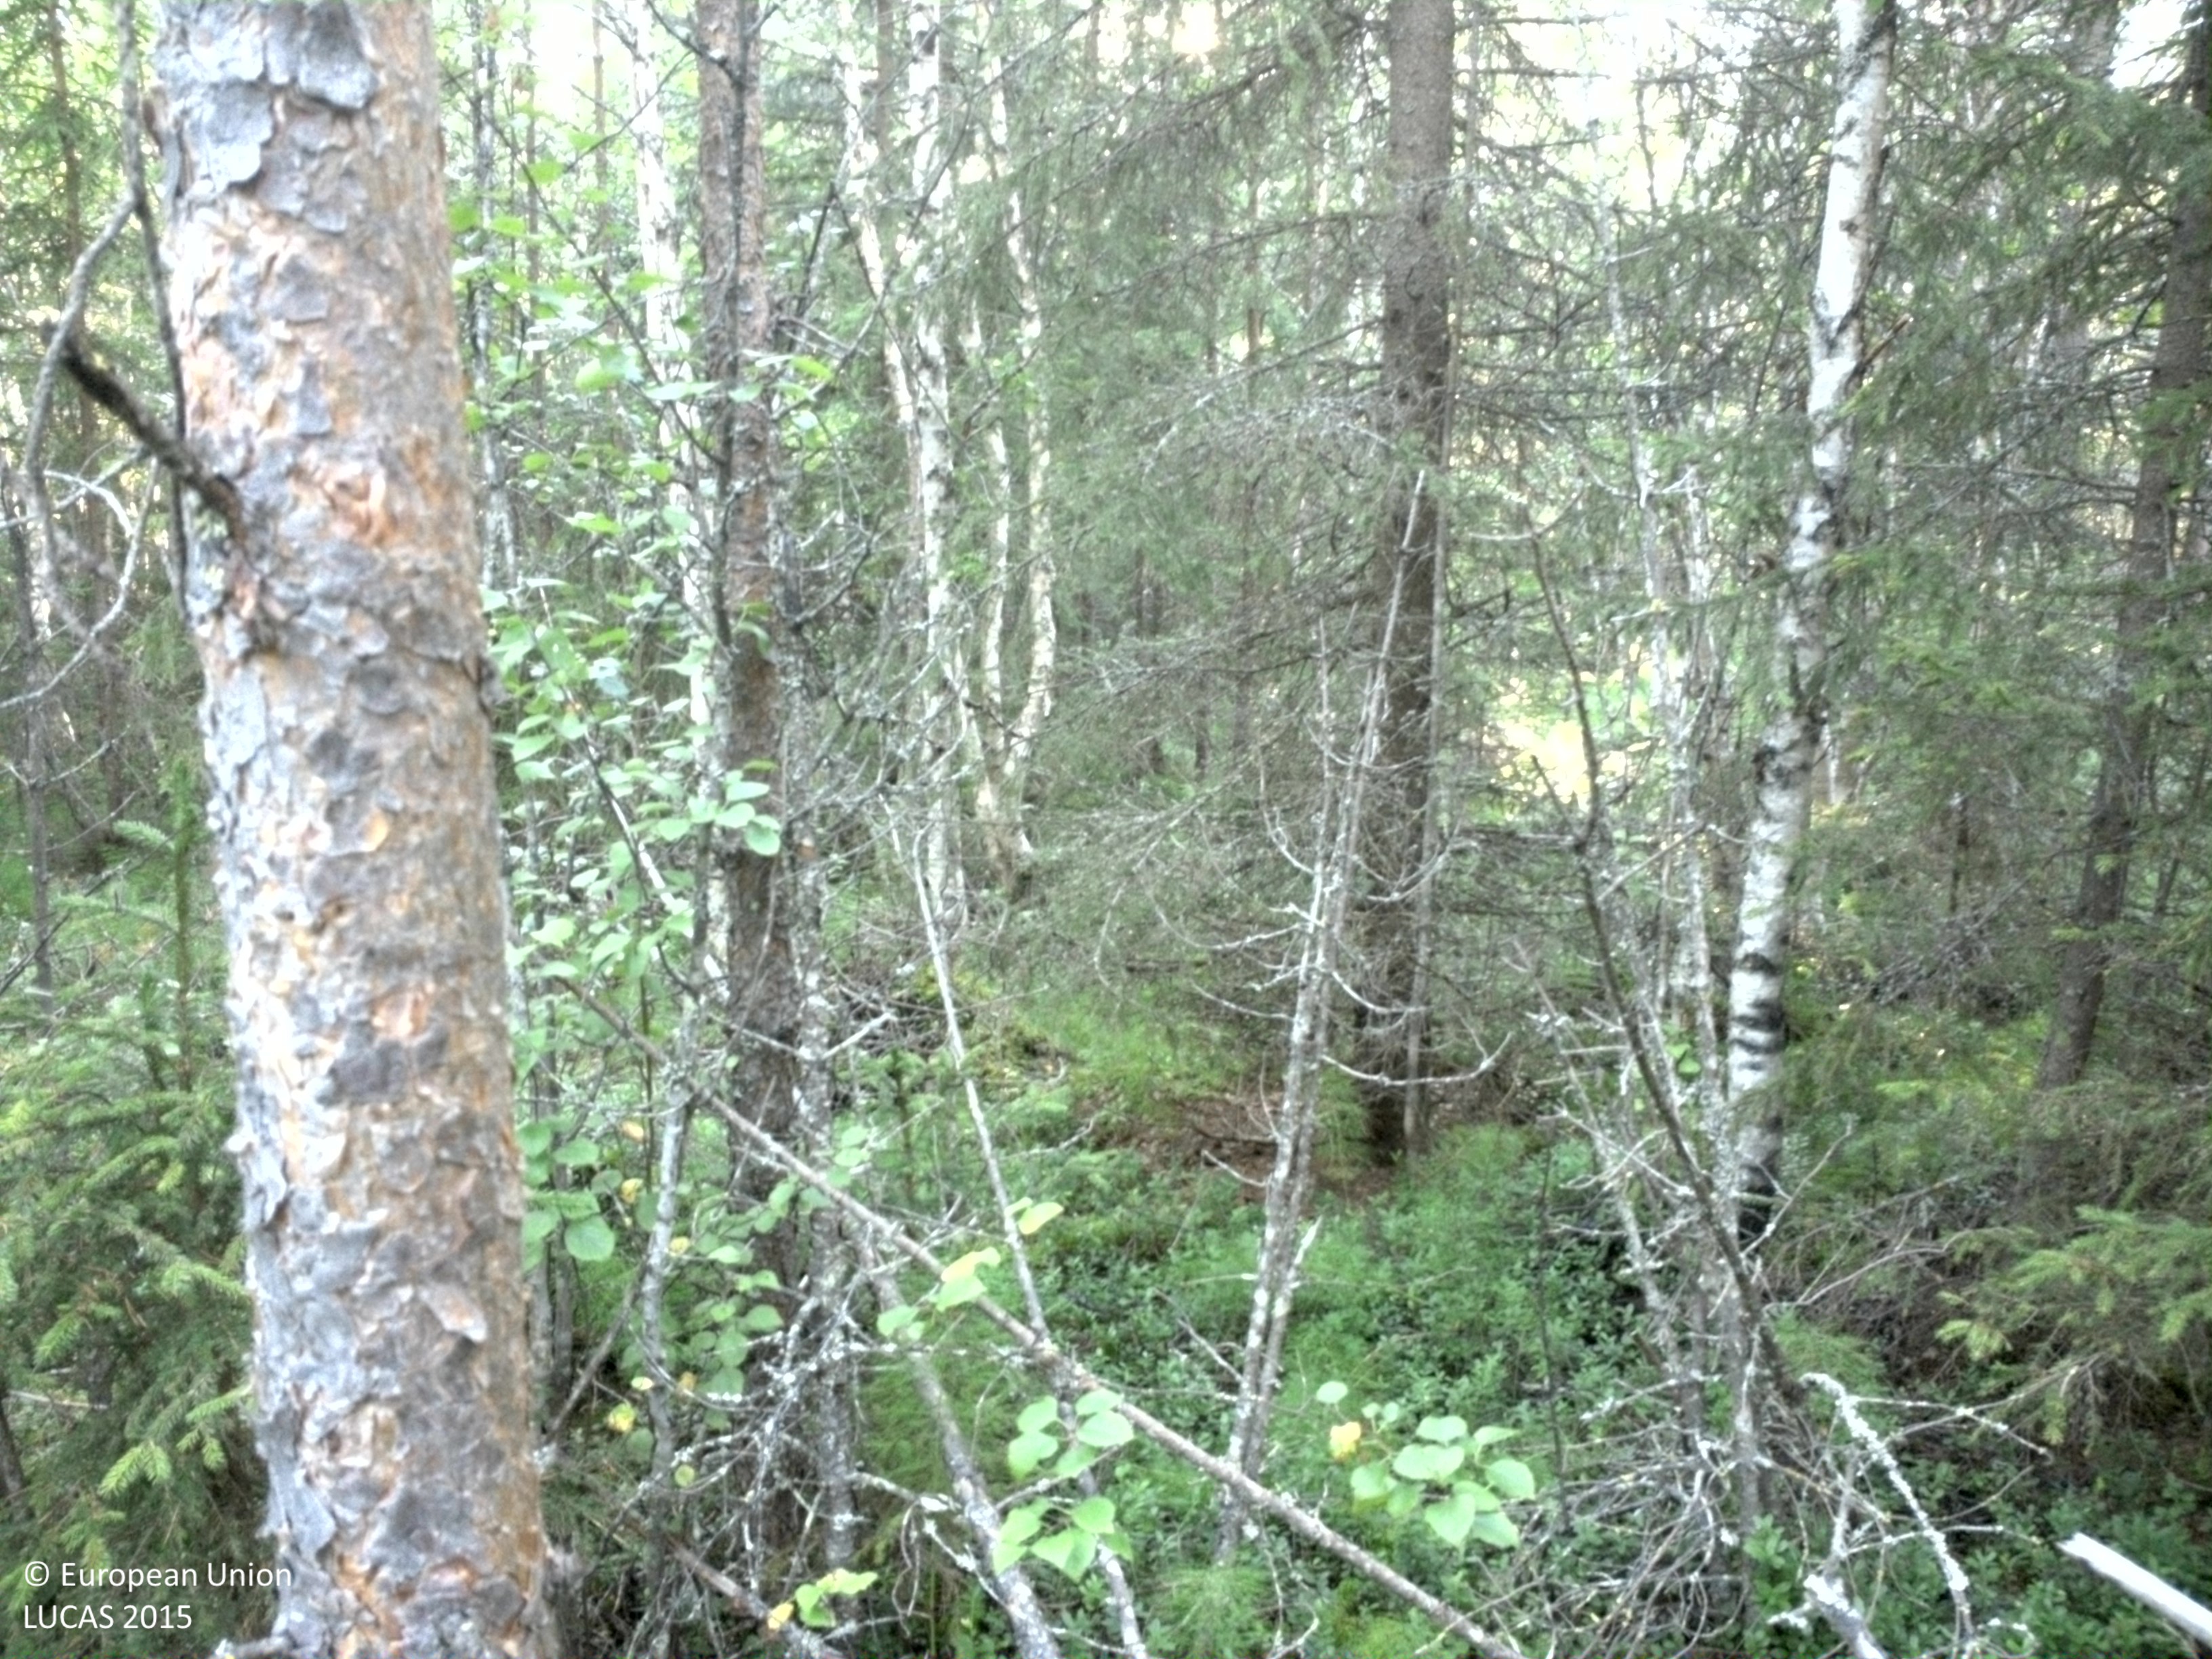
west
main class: Woodland
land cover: Pine dominated mixed woodland
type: boreal forest
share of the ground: > 75 %
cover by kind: coniferous forest trees 60 %, broadleaved forest trees 20 %, shrubs 20 %
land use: Forestry
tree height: > 5 m
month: August
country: SE
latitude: 64.5730
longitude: 20.8544
